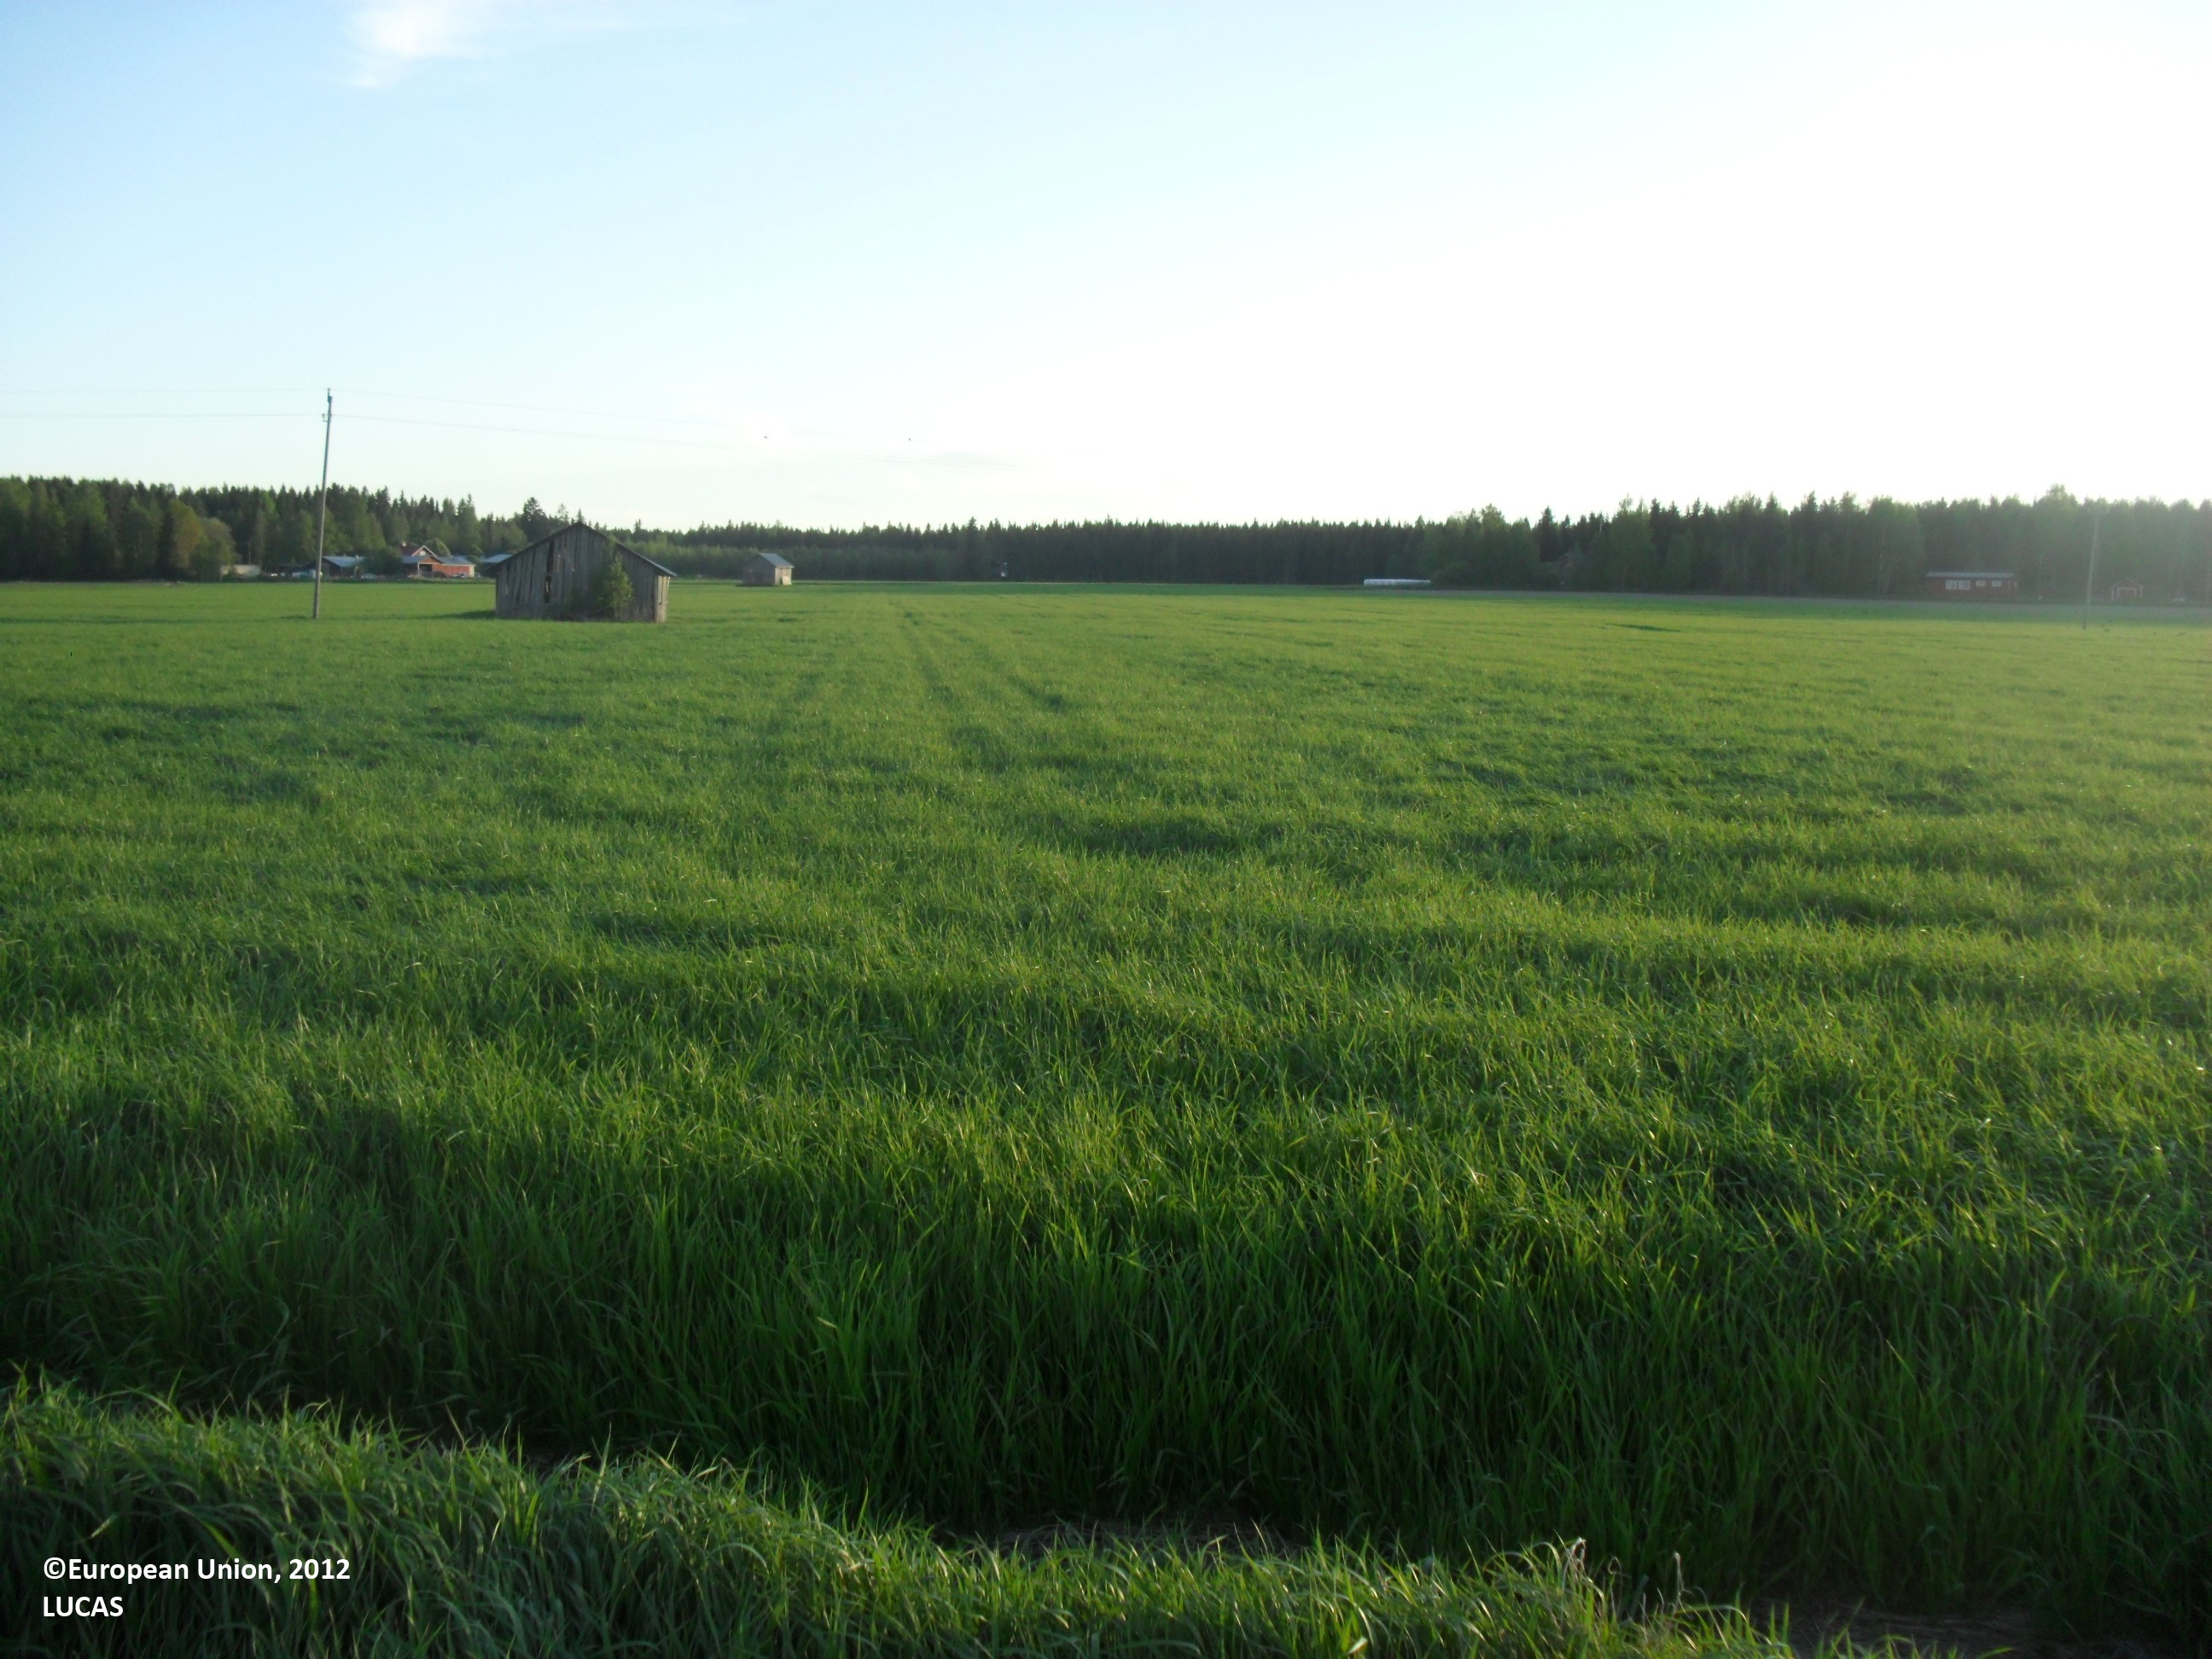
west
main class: Cropland
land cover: Temporary grasslands
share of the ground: > 75 %
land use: Agriculture (excluding fallow land and kitchen gardens)
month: June
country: FI
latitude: 62.9088
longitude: 23.1906
